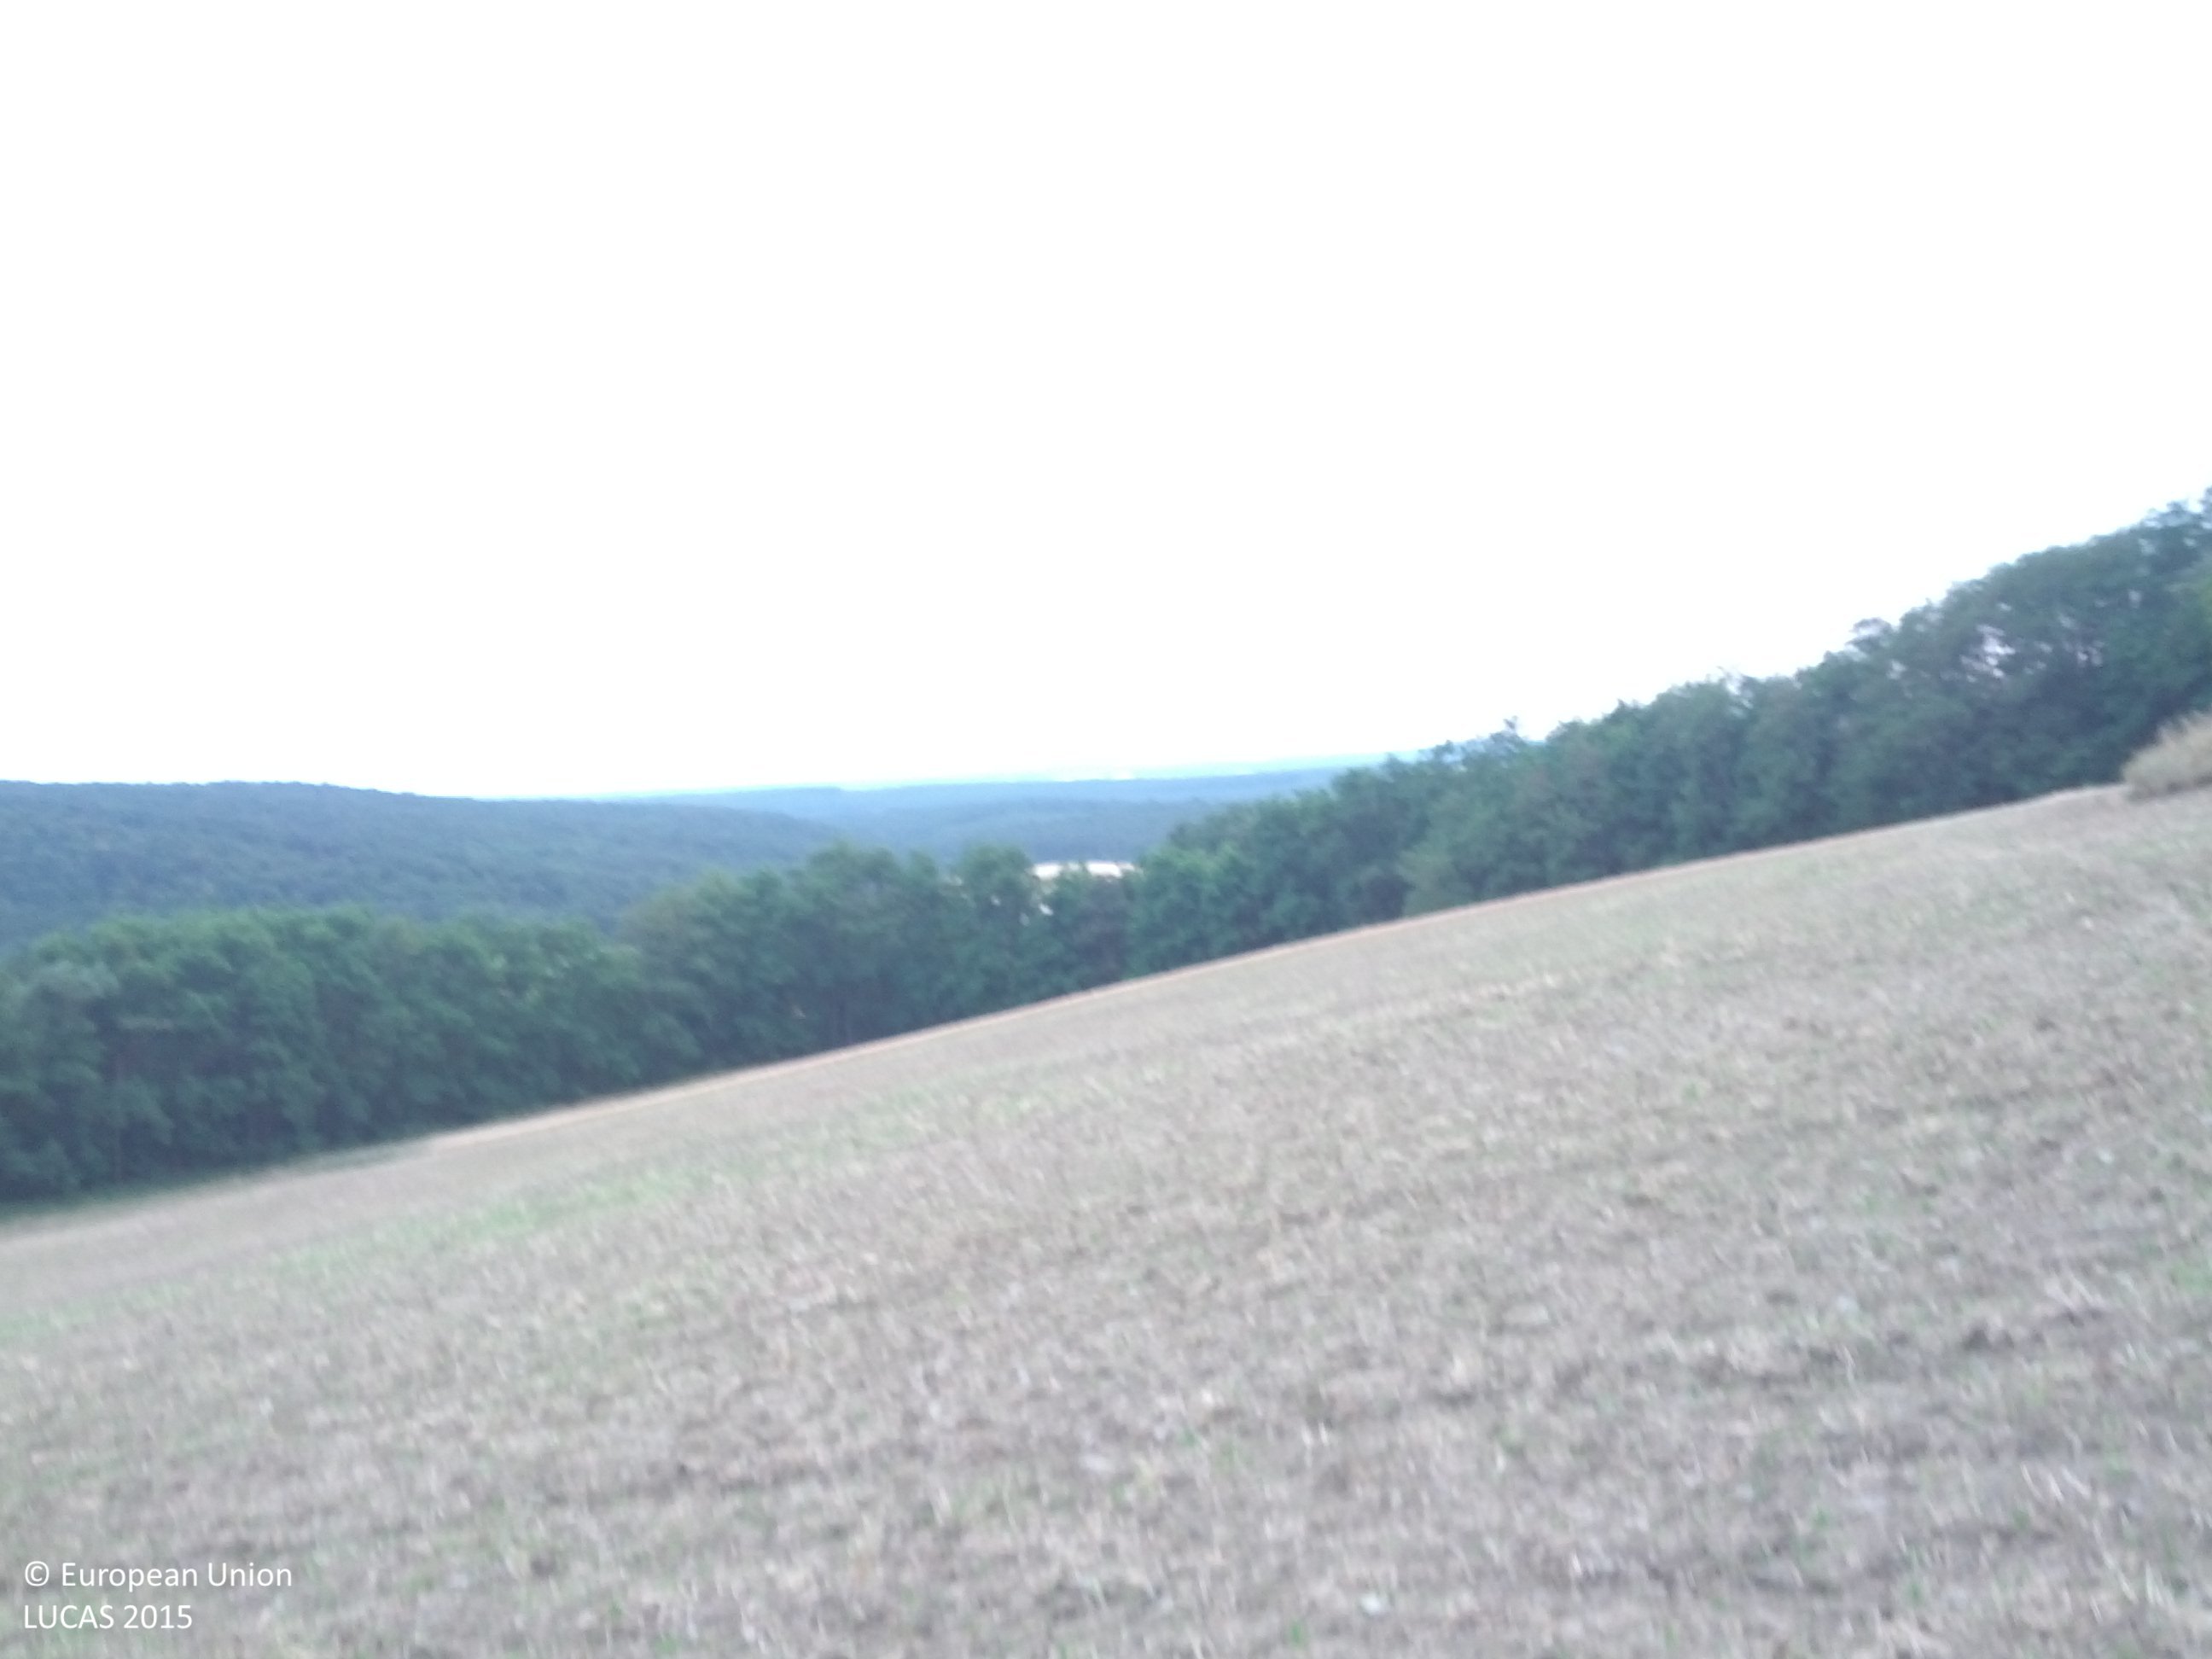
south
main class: Cropland
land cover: Barley
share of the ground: < 10 %
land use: Agriculture (excluding fallow land and kitchen gardens)
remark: Harvested field
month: July
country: AT
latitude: 47.3174
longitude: 16.3663
